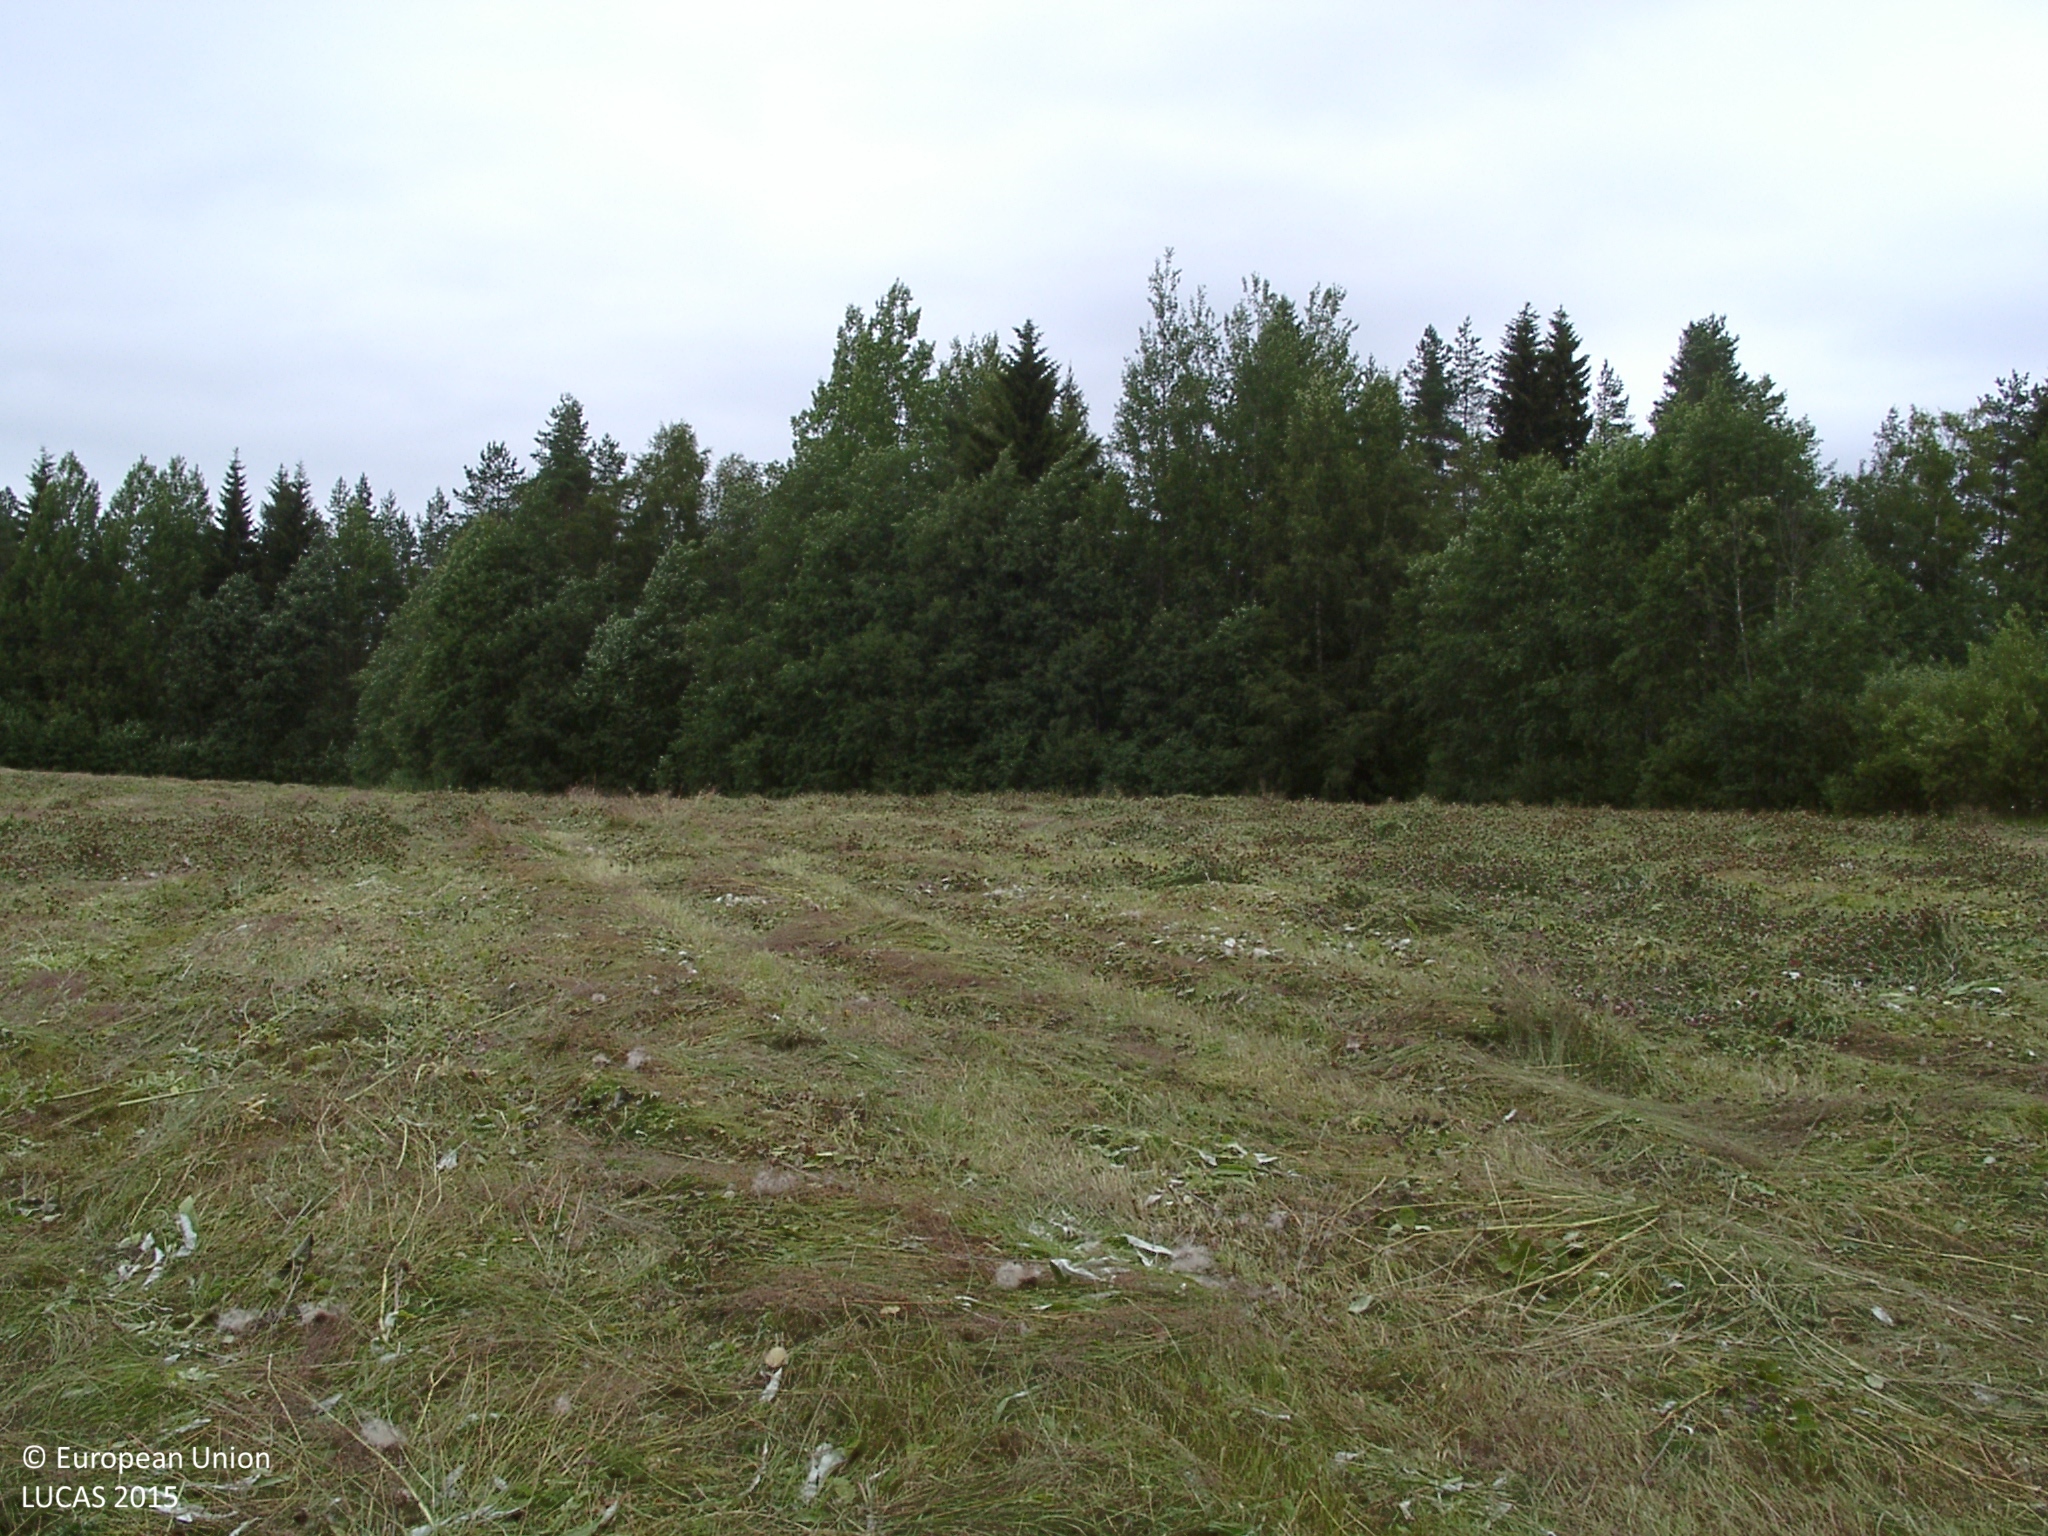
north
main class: Grassland
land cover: Spontaneously vegetated surfaces
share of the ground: > 75 %
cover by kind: herbaceous plants 100 %
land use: Fallow land
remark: Harvested field
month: August
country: FI
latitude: 62.6898
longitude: 24.5660
